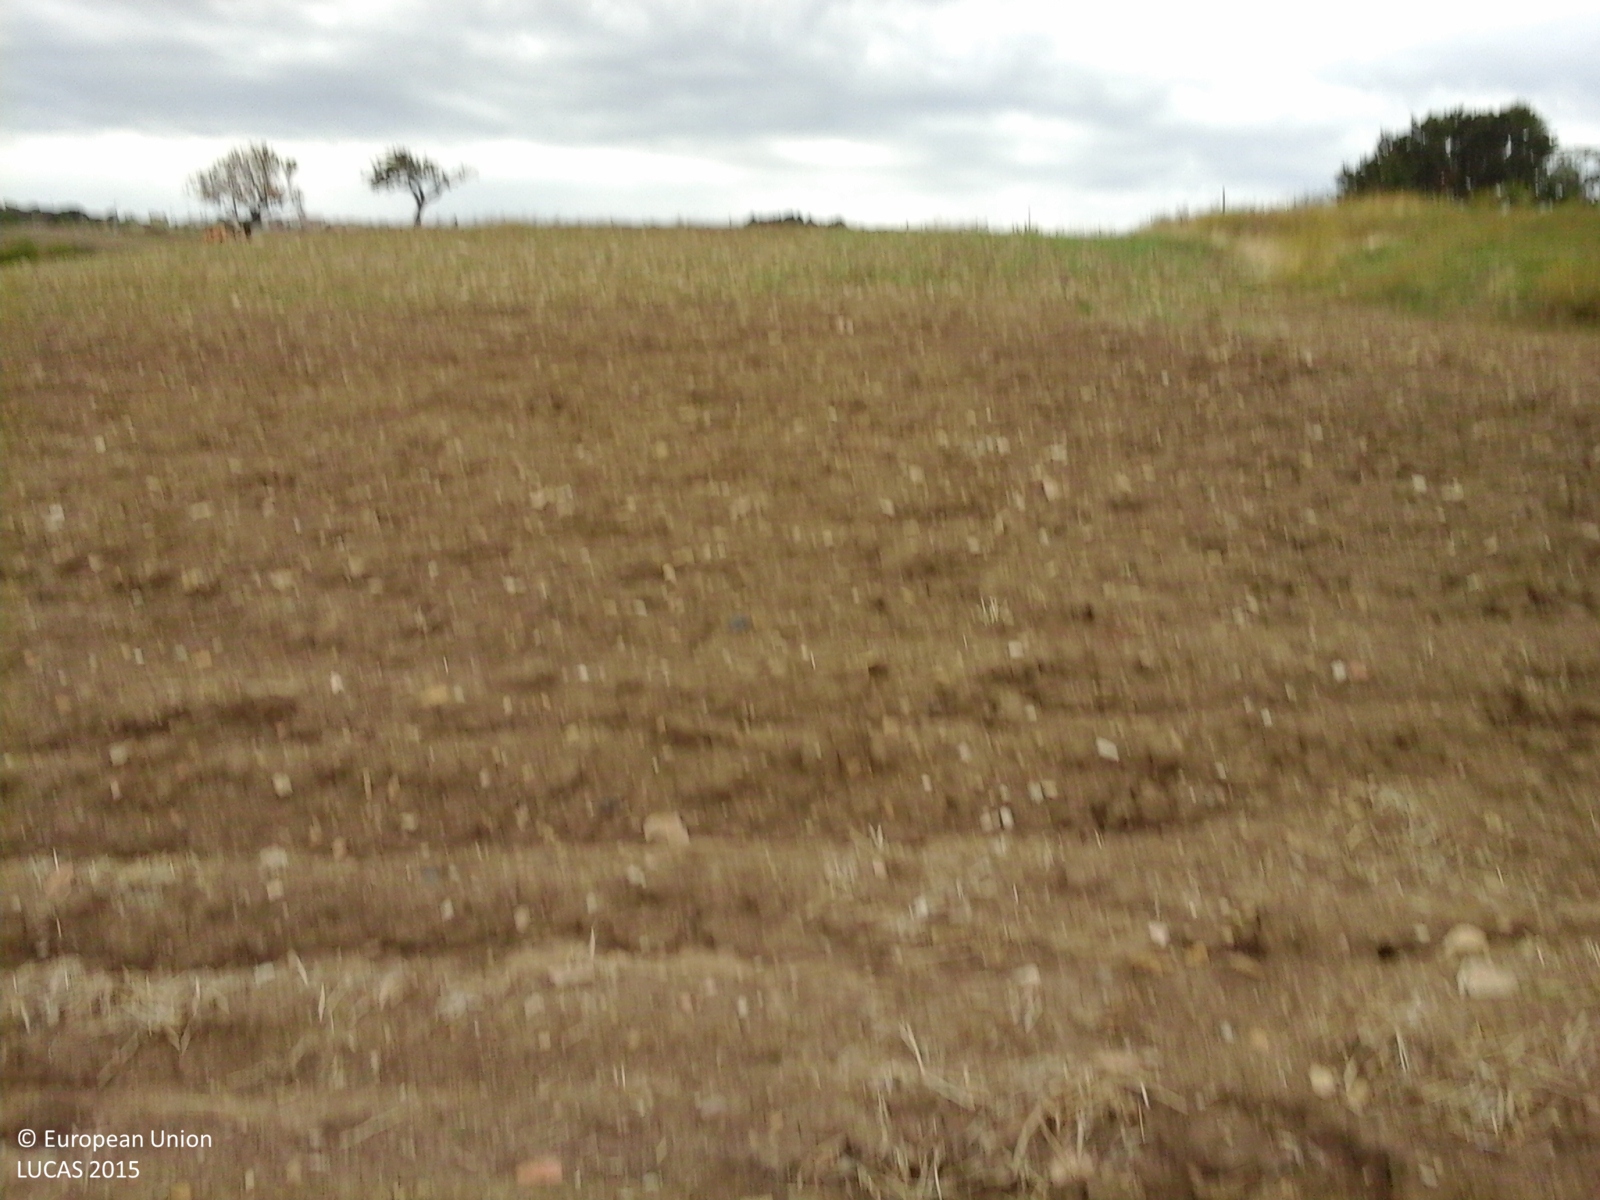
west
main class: Cropland
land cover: Barley
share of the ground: > 75 %
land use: Agriculture (excluding fallow land and kitchen gardens)
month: October
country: IT
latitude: 41.6009
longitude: 15.1303
